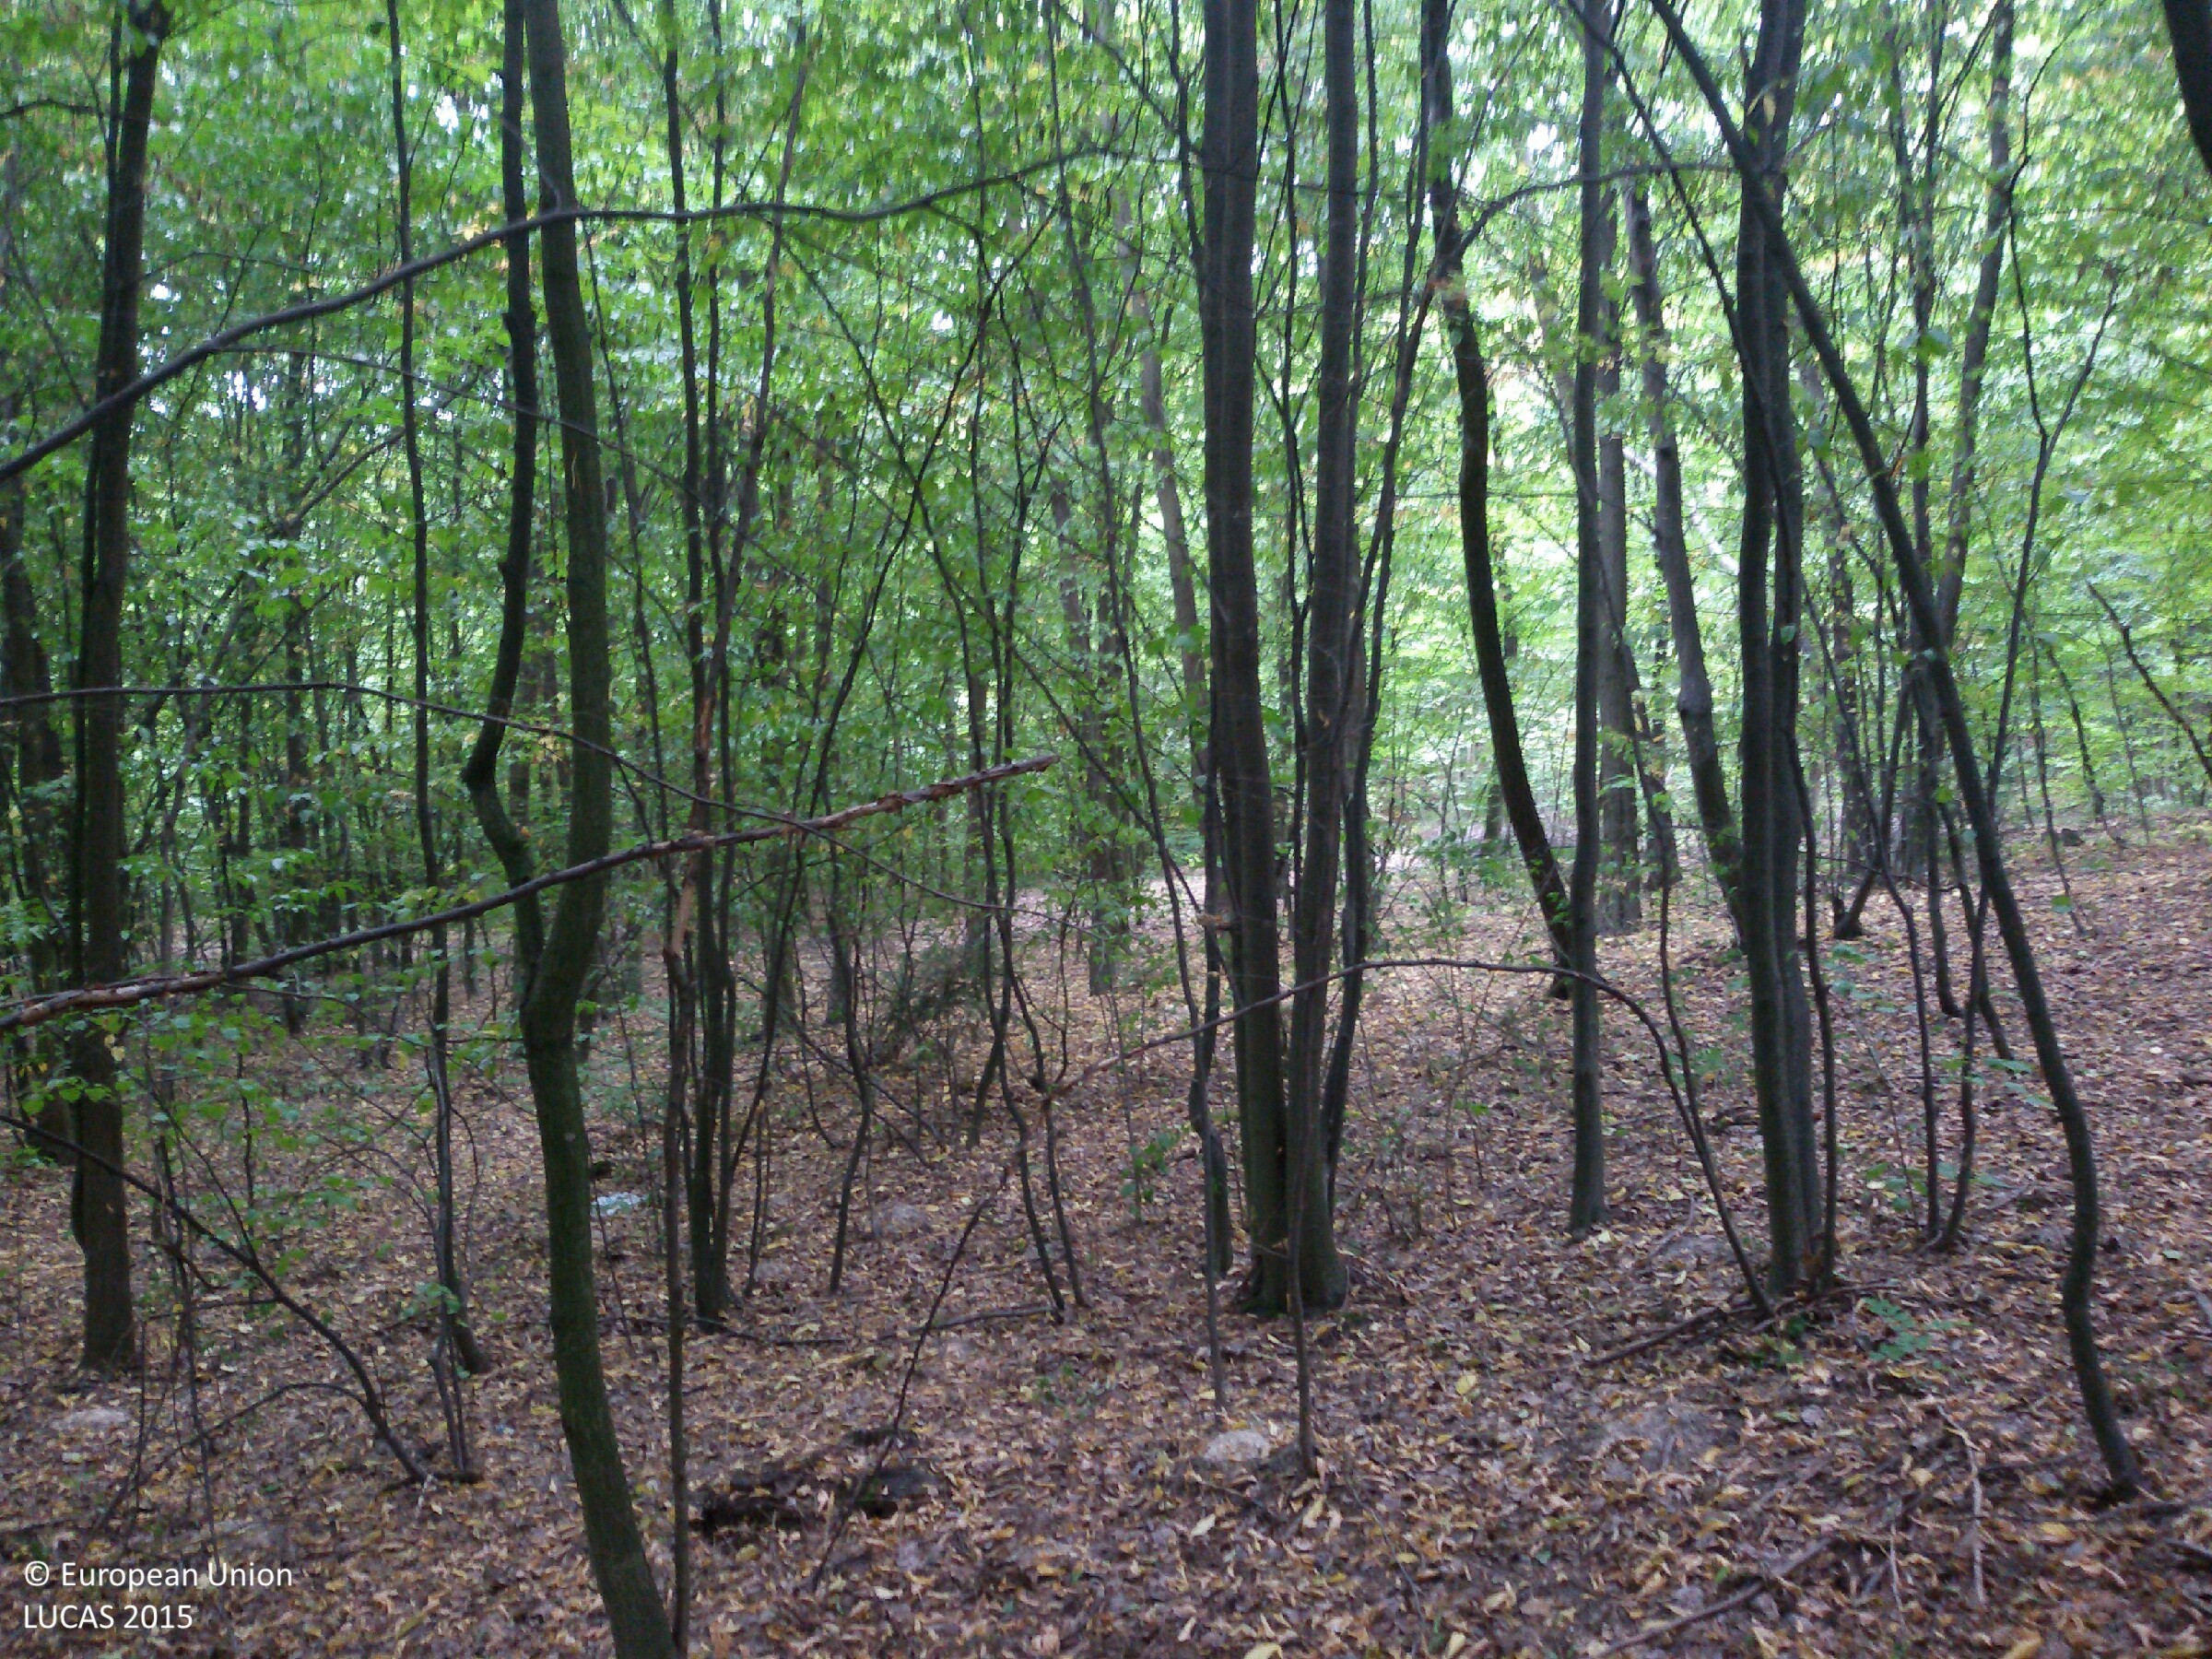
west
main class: Woodland
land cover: Broadleaved woodland
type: mesophytic deciduous forest
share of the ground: > 75 %
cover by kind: broadleaved forest trees 100 %
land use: Forestry
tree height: > 5 m
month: August
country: PL
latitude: 50.8471
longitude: 21.7435
